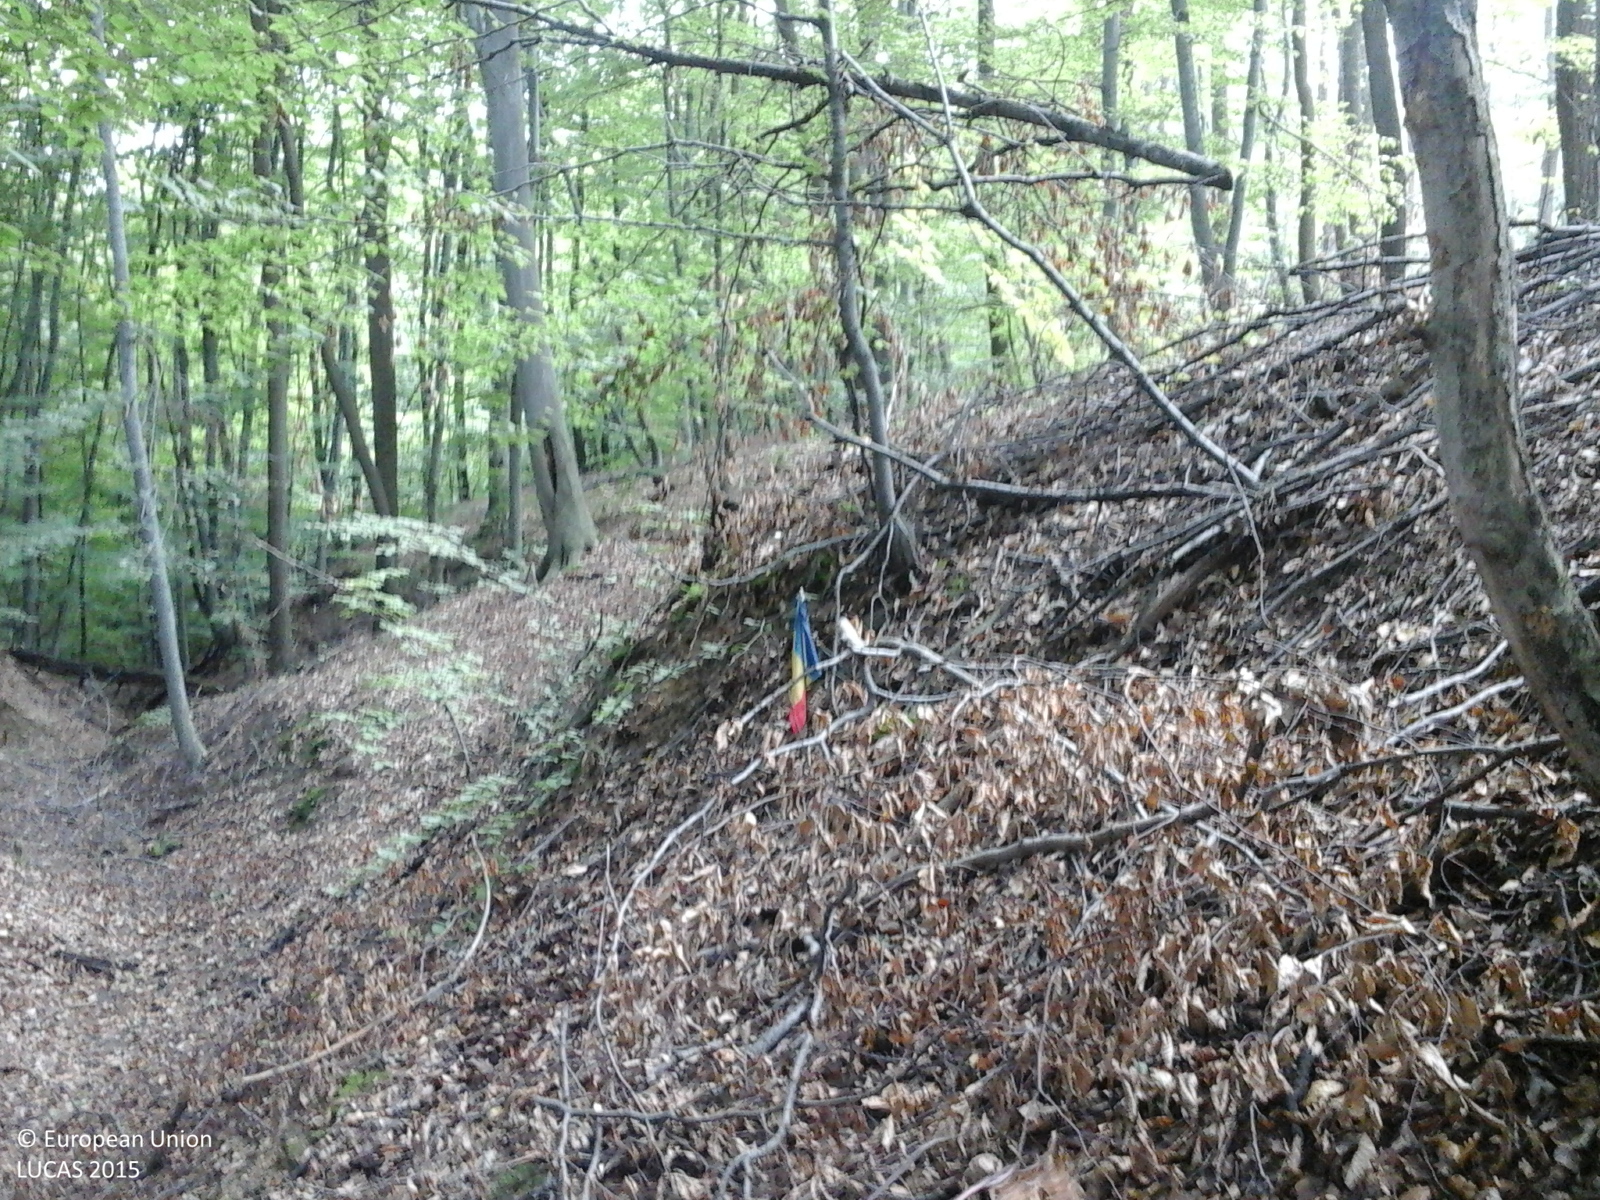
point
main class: Woodland
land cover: Broadleaved woodland
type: acidophilous oak and oak-birch forest
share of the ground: > 75 %
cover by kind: broadleaved forest trees 100 %
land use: Forestry
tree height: > 5 m
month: September
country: RO
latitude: 45.8402
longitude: 23.3351
